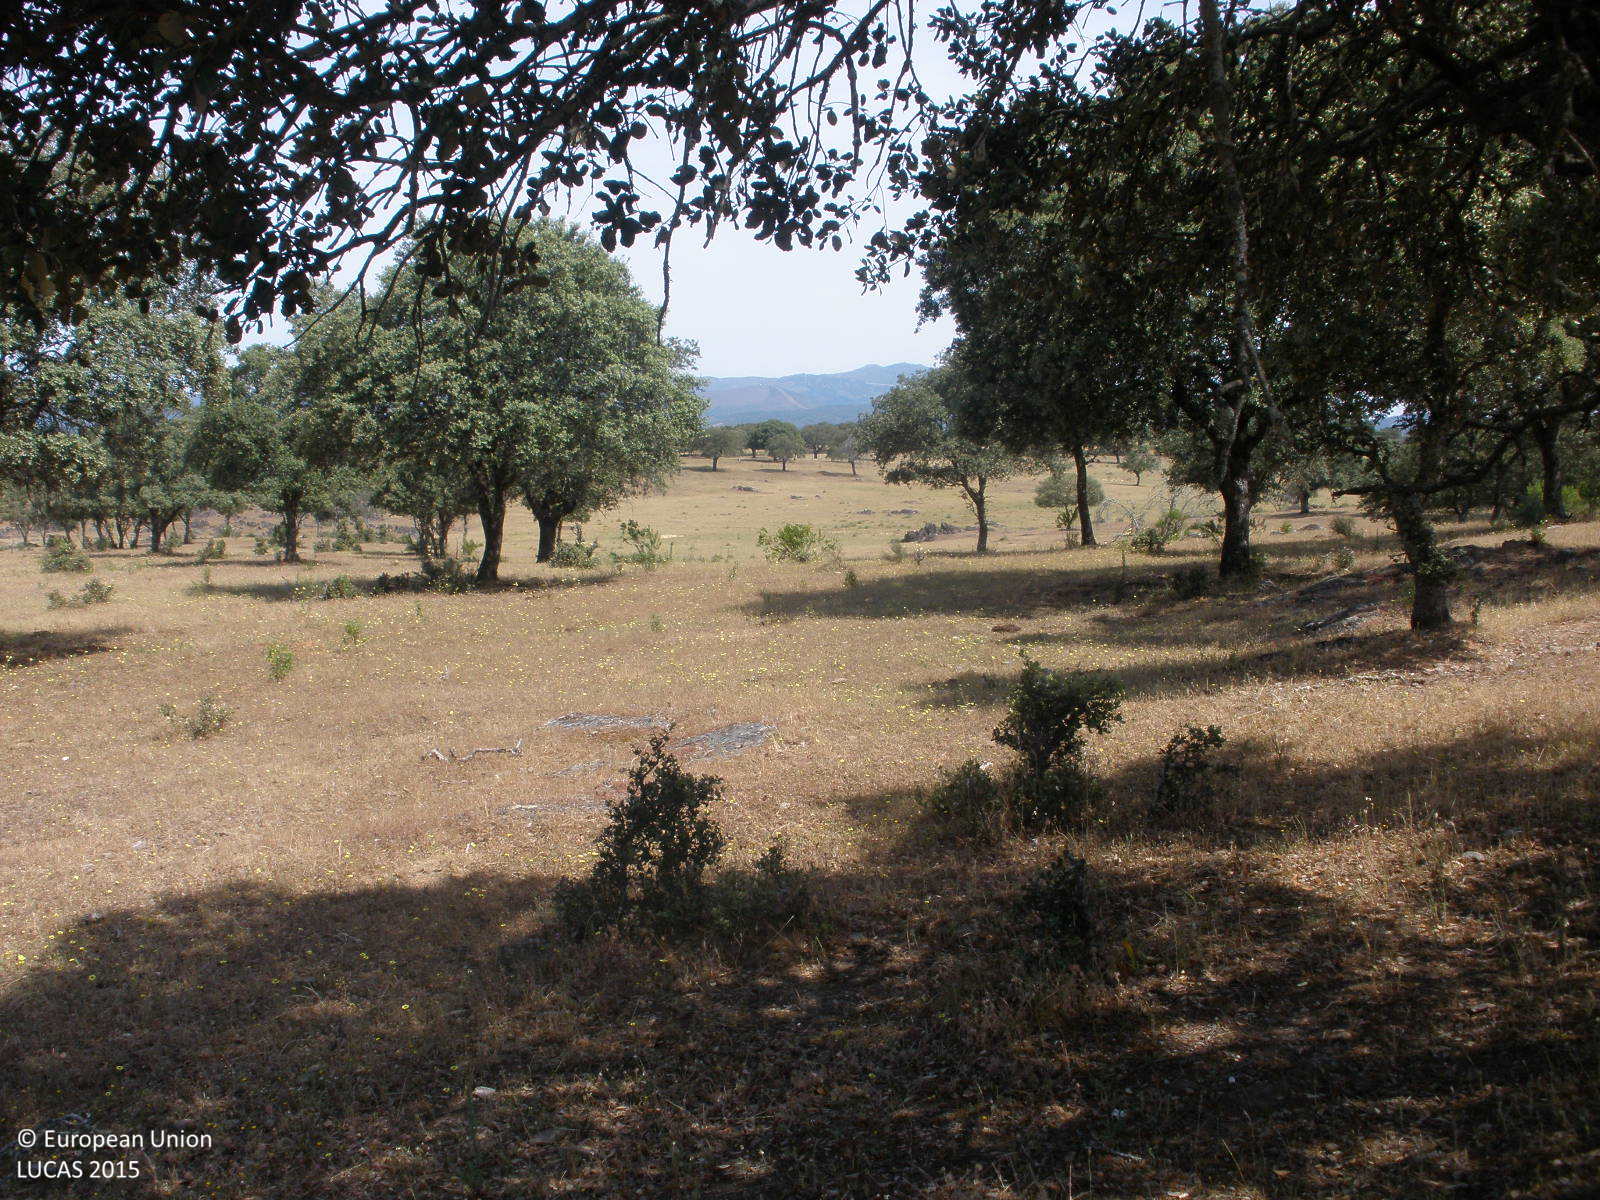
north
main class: Woodland
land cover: Broadleaved woodland
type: broadleaved evergreen forest
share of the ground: 50 - 75 %
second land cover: Grassland without tree/shrub cover
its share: > 75 %
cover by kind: herbaceous plants 60 %, broadleaved forest trees 40 %
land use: Forestry
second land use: Agriculture (excluding fallow land and kitchen gardens)
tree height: < 5 m
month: May
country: ES
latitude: 40.0970
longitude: -6.5869
